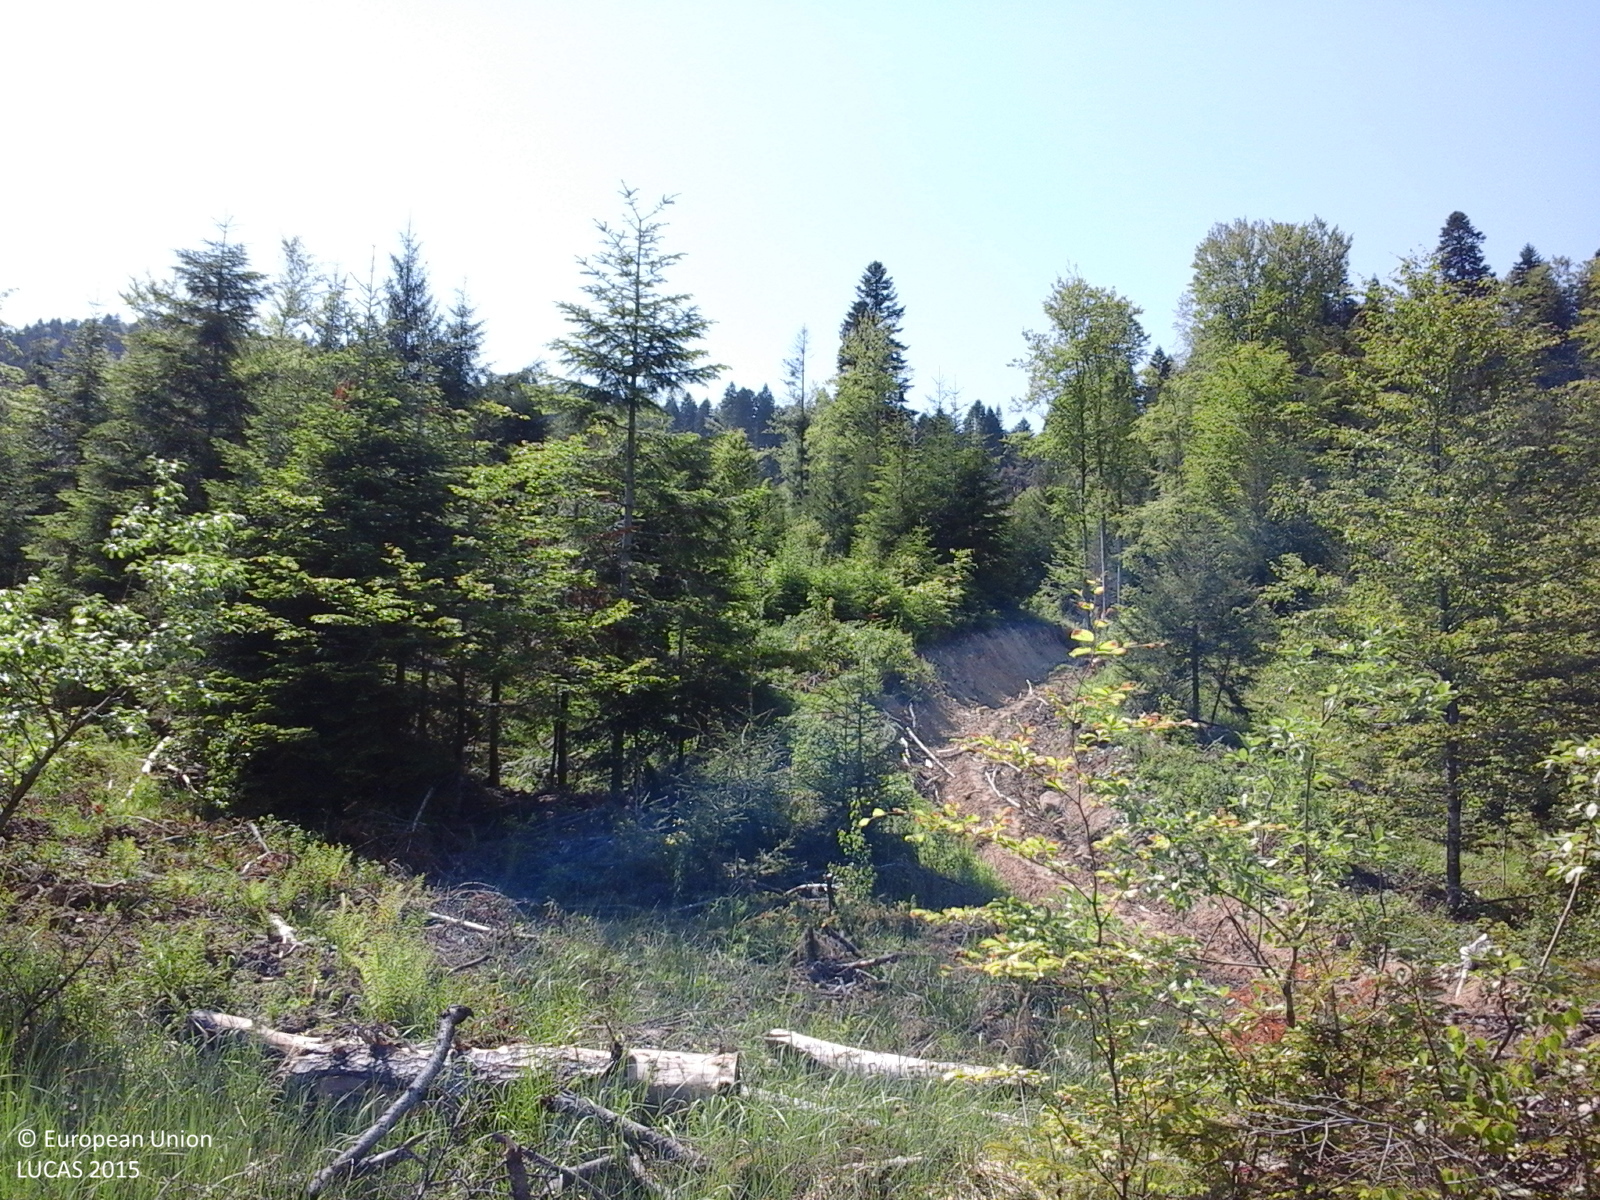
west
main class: Shrubland
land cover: Shrubland with sparse tree cover
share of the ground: > 75 %
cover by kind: shrubs 75 %, herbaceous plants 20 %, broadleaved forest trees 5 %
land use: Forestry
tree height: < 5 m
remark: Clear cut
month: May
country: RO
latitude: 45.6094
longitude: 26.5009
